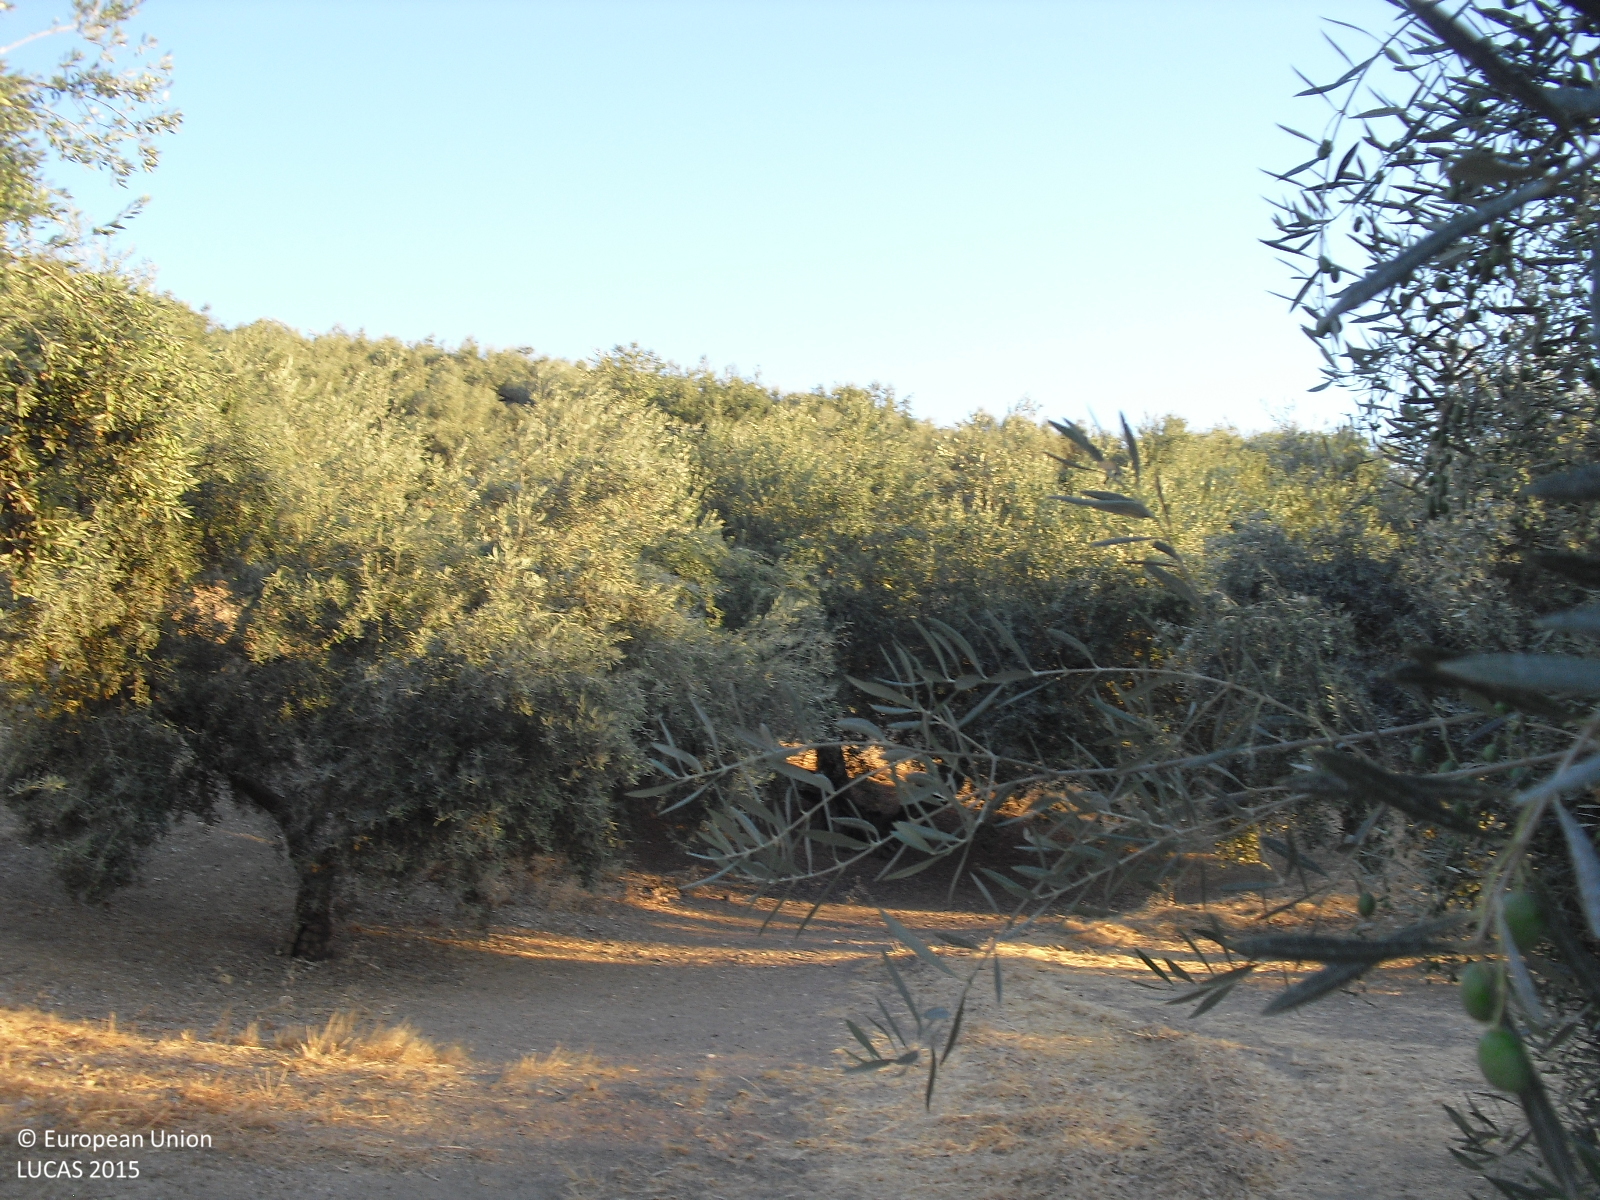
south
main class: Cropland
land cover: Olive groves
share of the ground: 25 - 50 %
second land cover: Other bare soil
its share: > 75 %
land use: Agriculture (excluding fallow land and kitchen gardens)
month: August
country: ES
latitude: 37.2396
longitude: -4.1200
